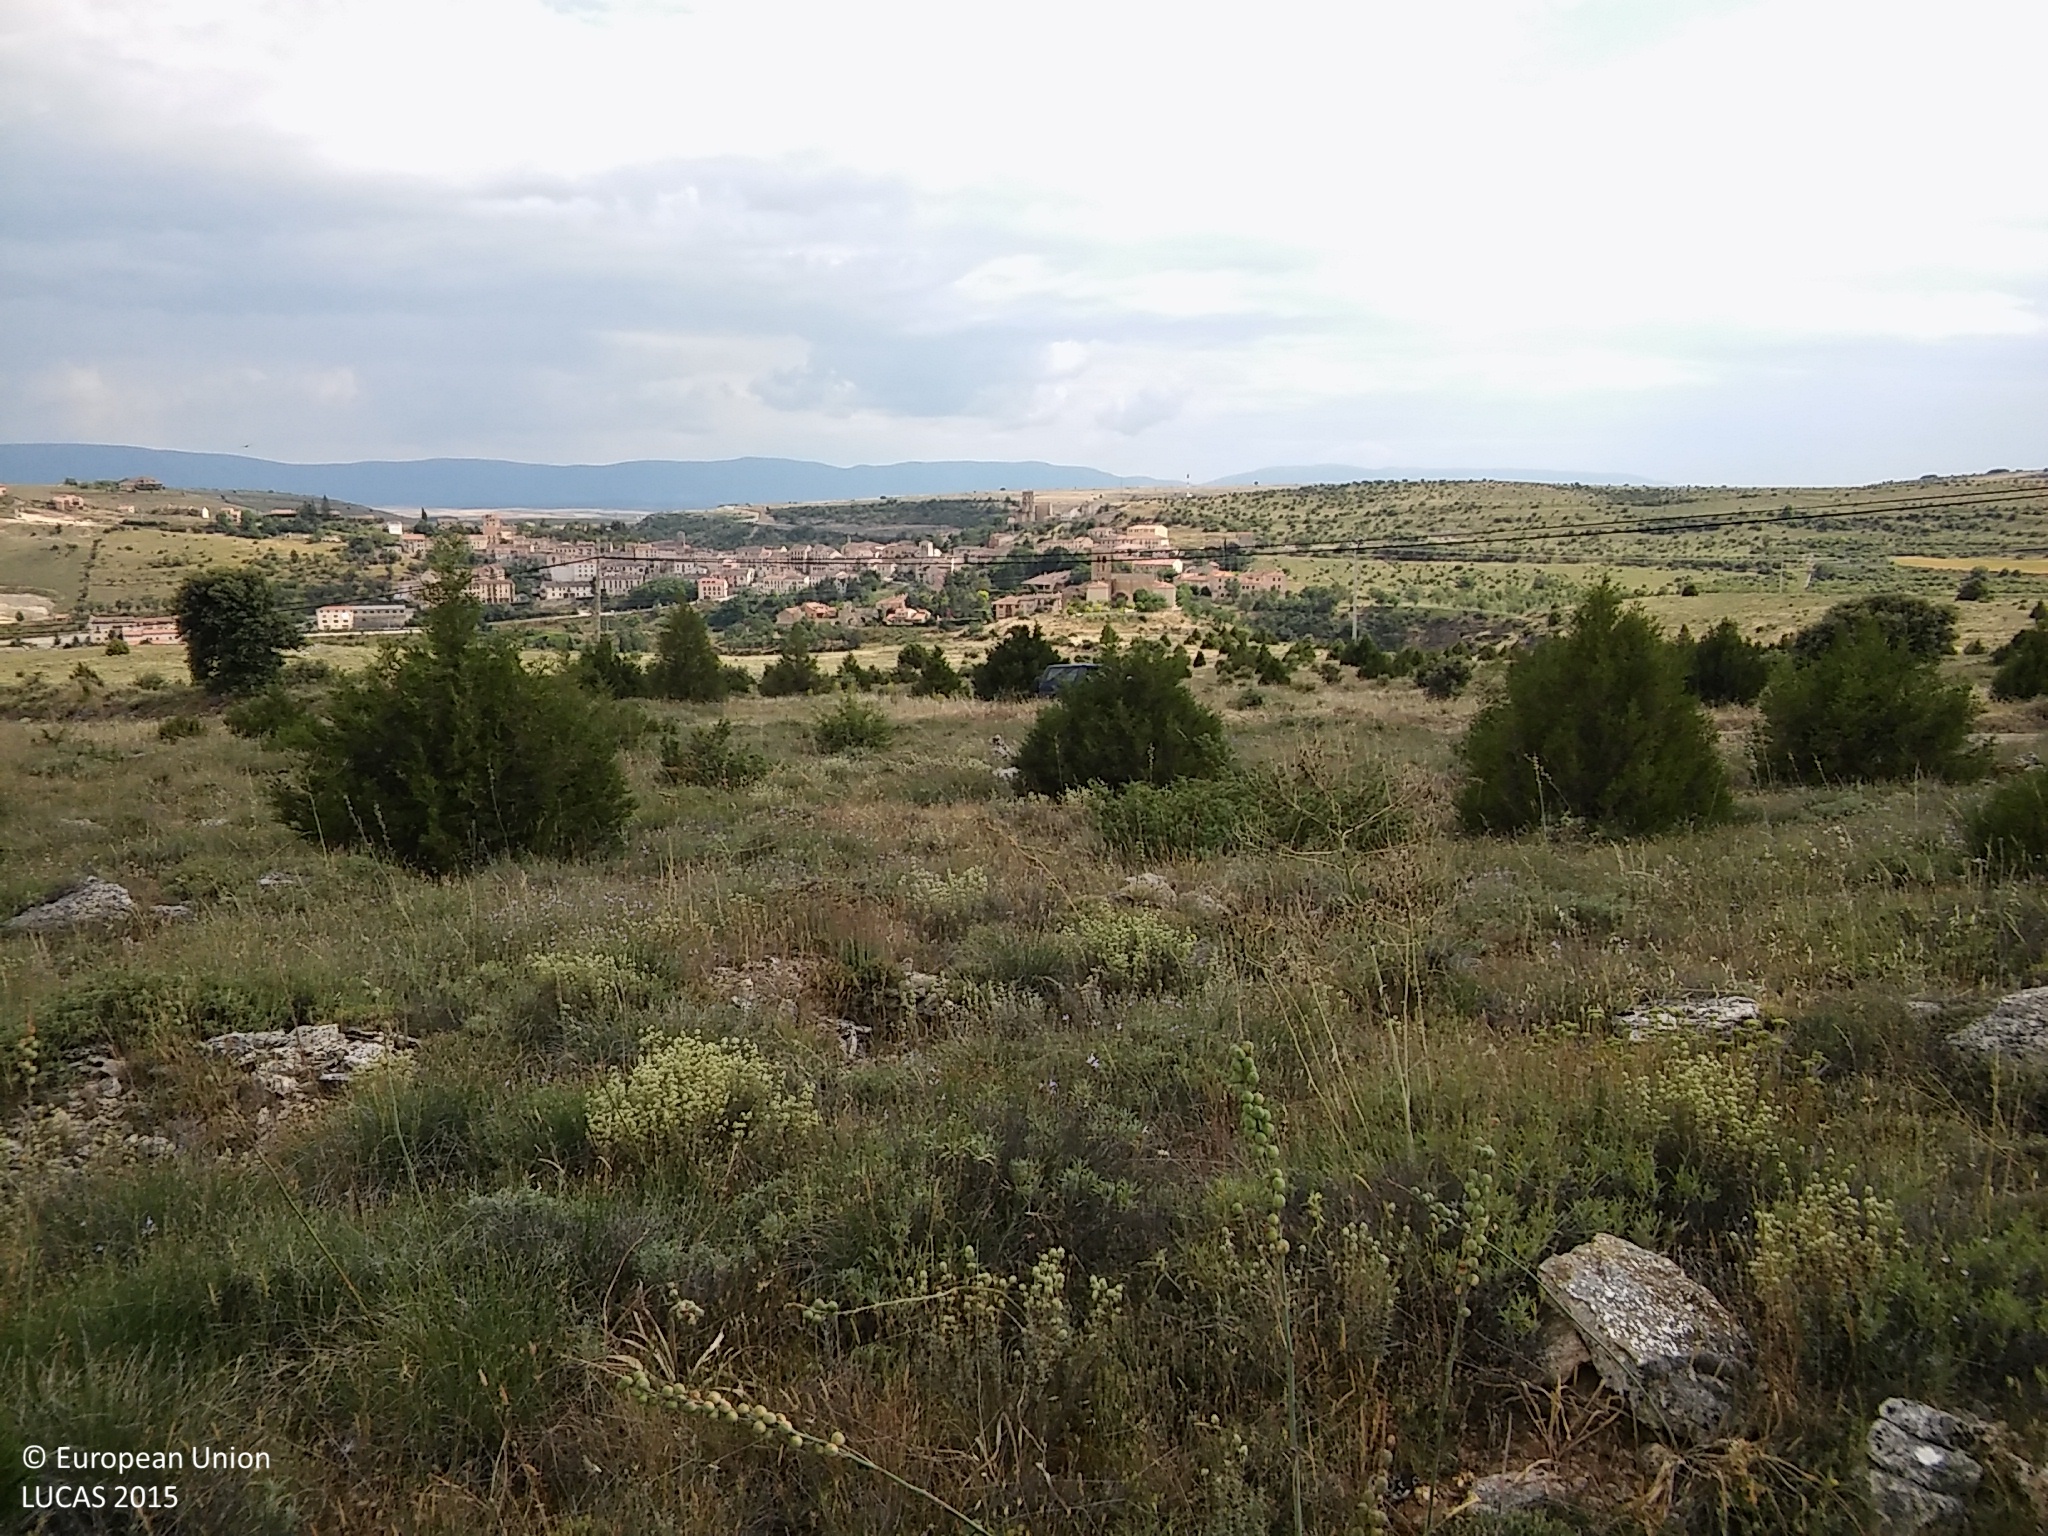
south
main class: Woodland
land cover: Other coniferous woodland
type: coniferous forest of the mediterranean region
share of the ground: 10 - 25 %
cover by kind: shrubs 50 %, herbaceous plants 20 %, unconsolidated bare surface 20 %, coniferous forest trees 10 %
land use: Semi-natural and natural areas not in use
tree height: < 5 m
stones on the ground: 25 - 50 %
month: June
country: ES
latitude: 41.3088
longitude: -3.7496
